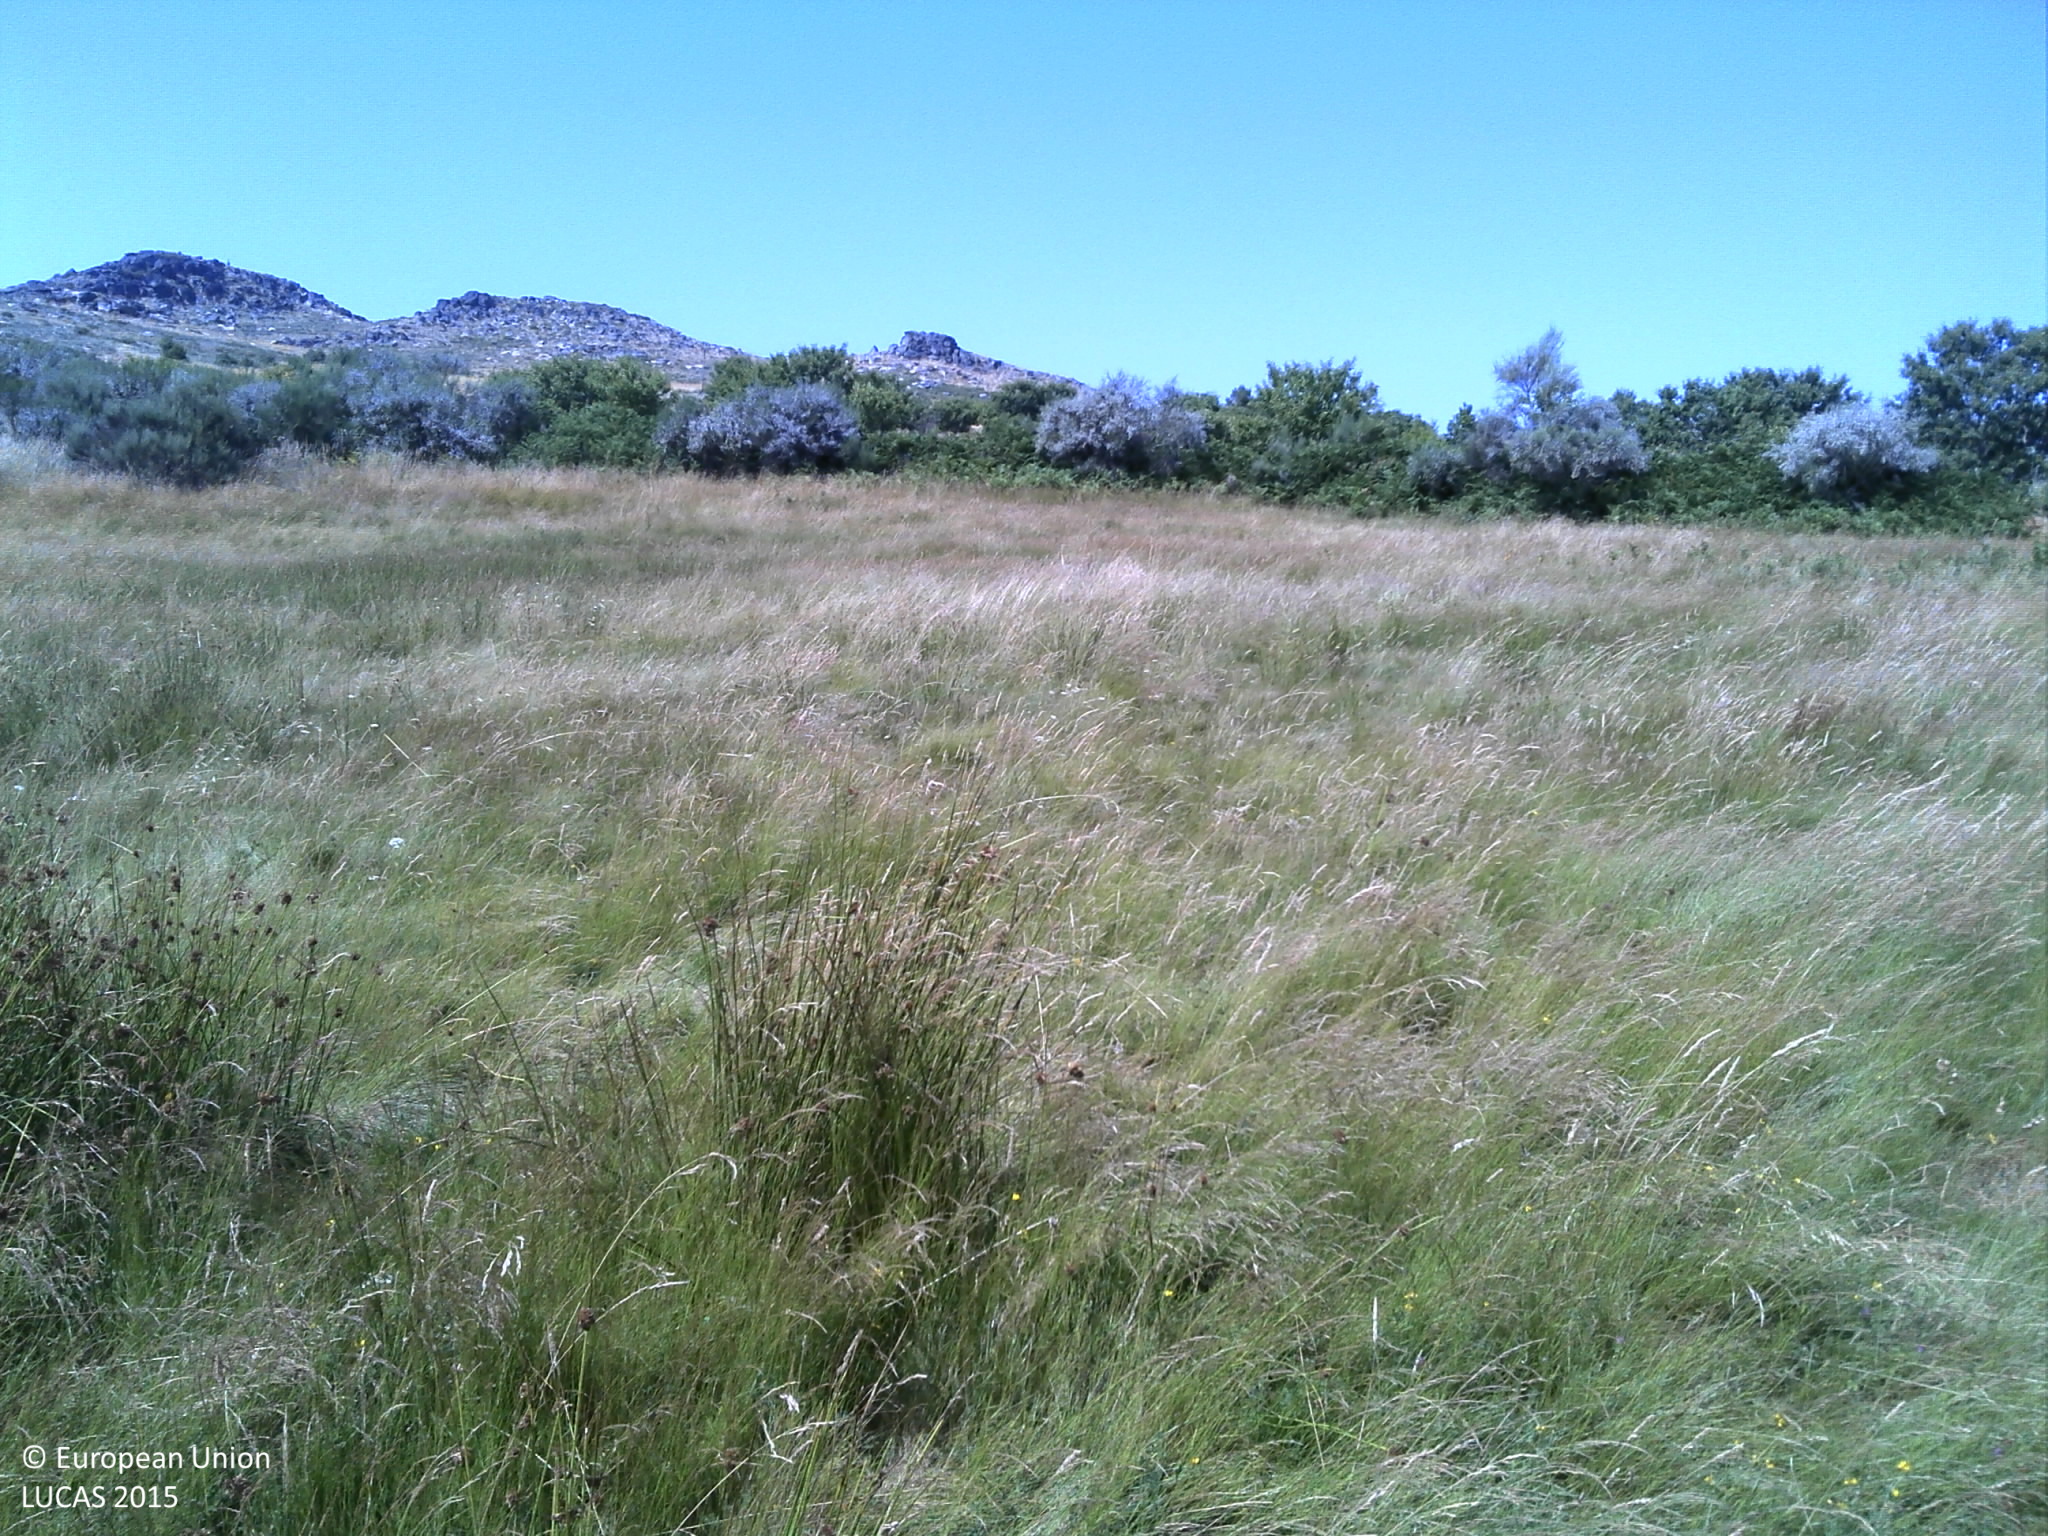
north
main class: Grassland
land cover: Grassland without tree/shrub cover
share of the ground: > 75 %
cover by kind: herbaceous plants 90 %, unconsolidated bare surface 10 %
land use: Agriculture (excluding fallow land and kitchen gardens)
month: July
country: PT
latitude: 41.0334
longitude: -7.4488
